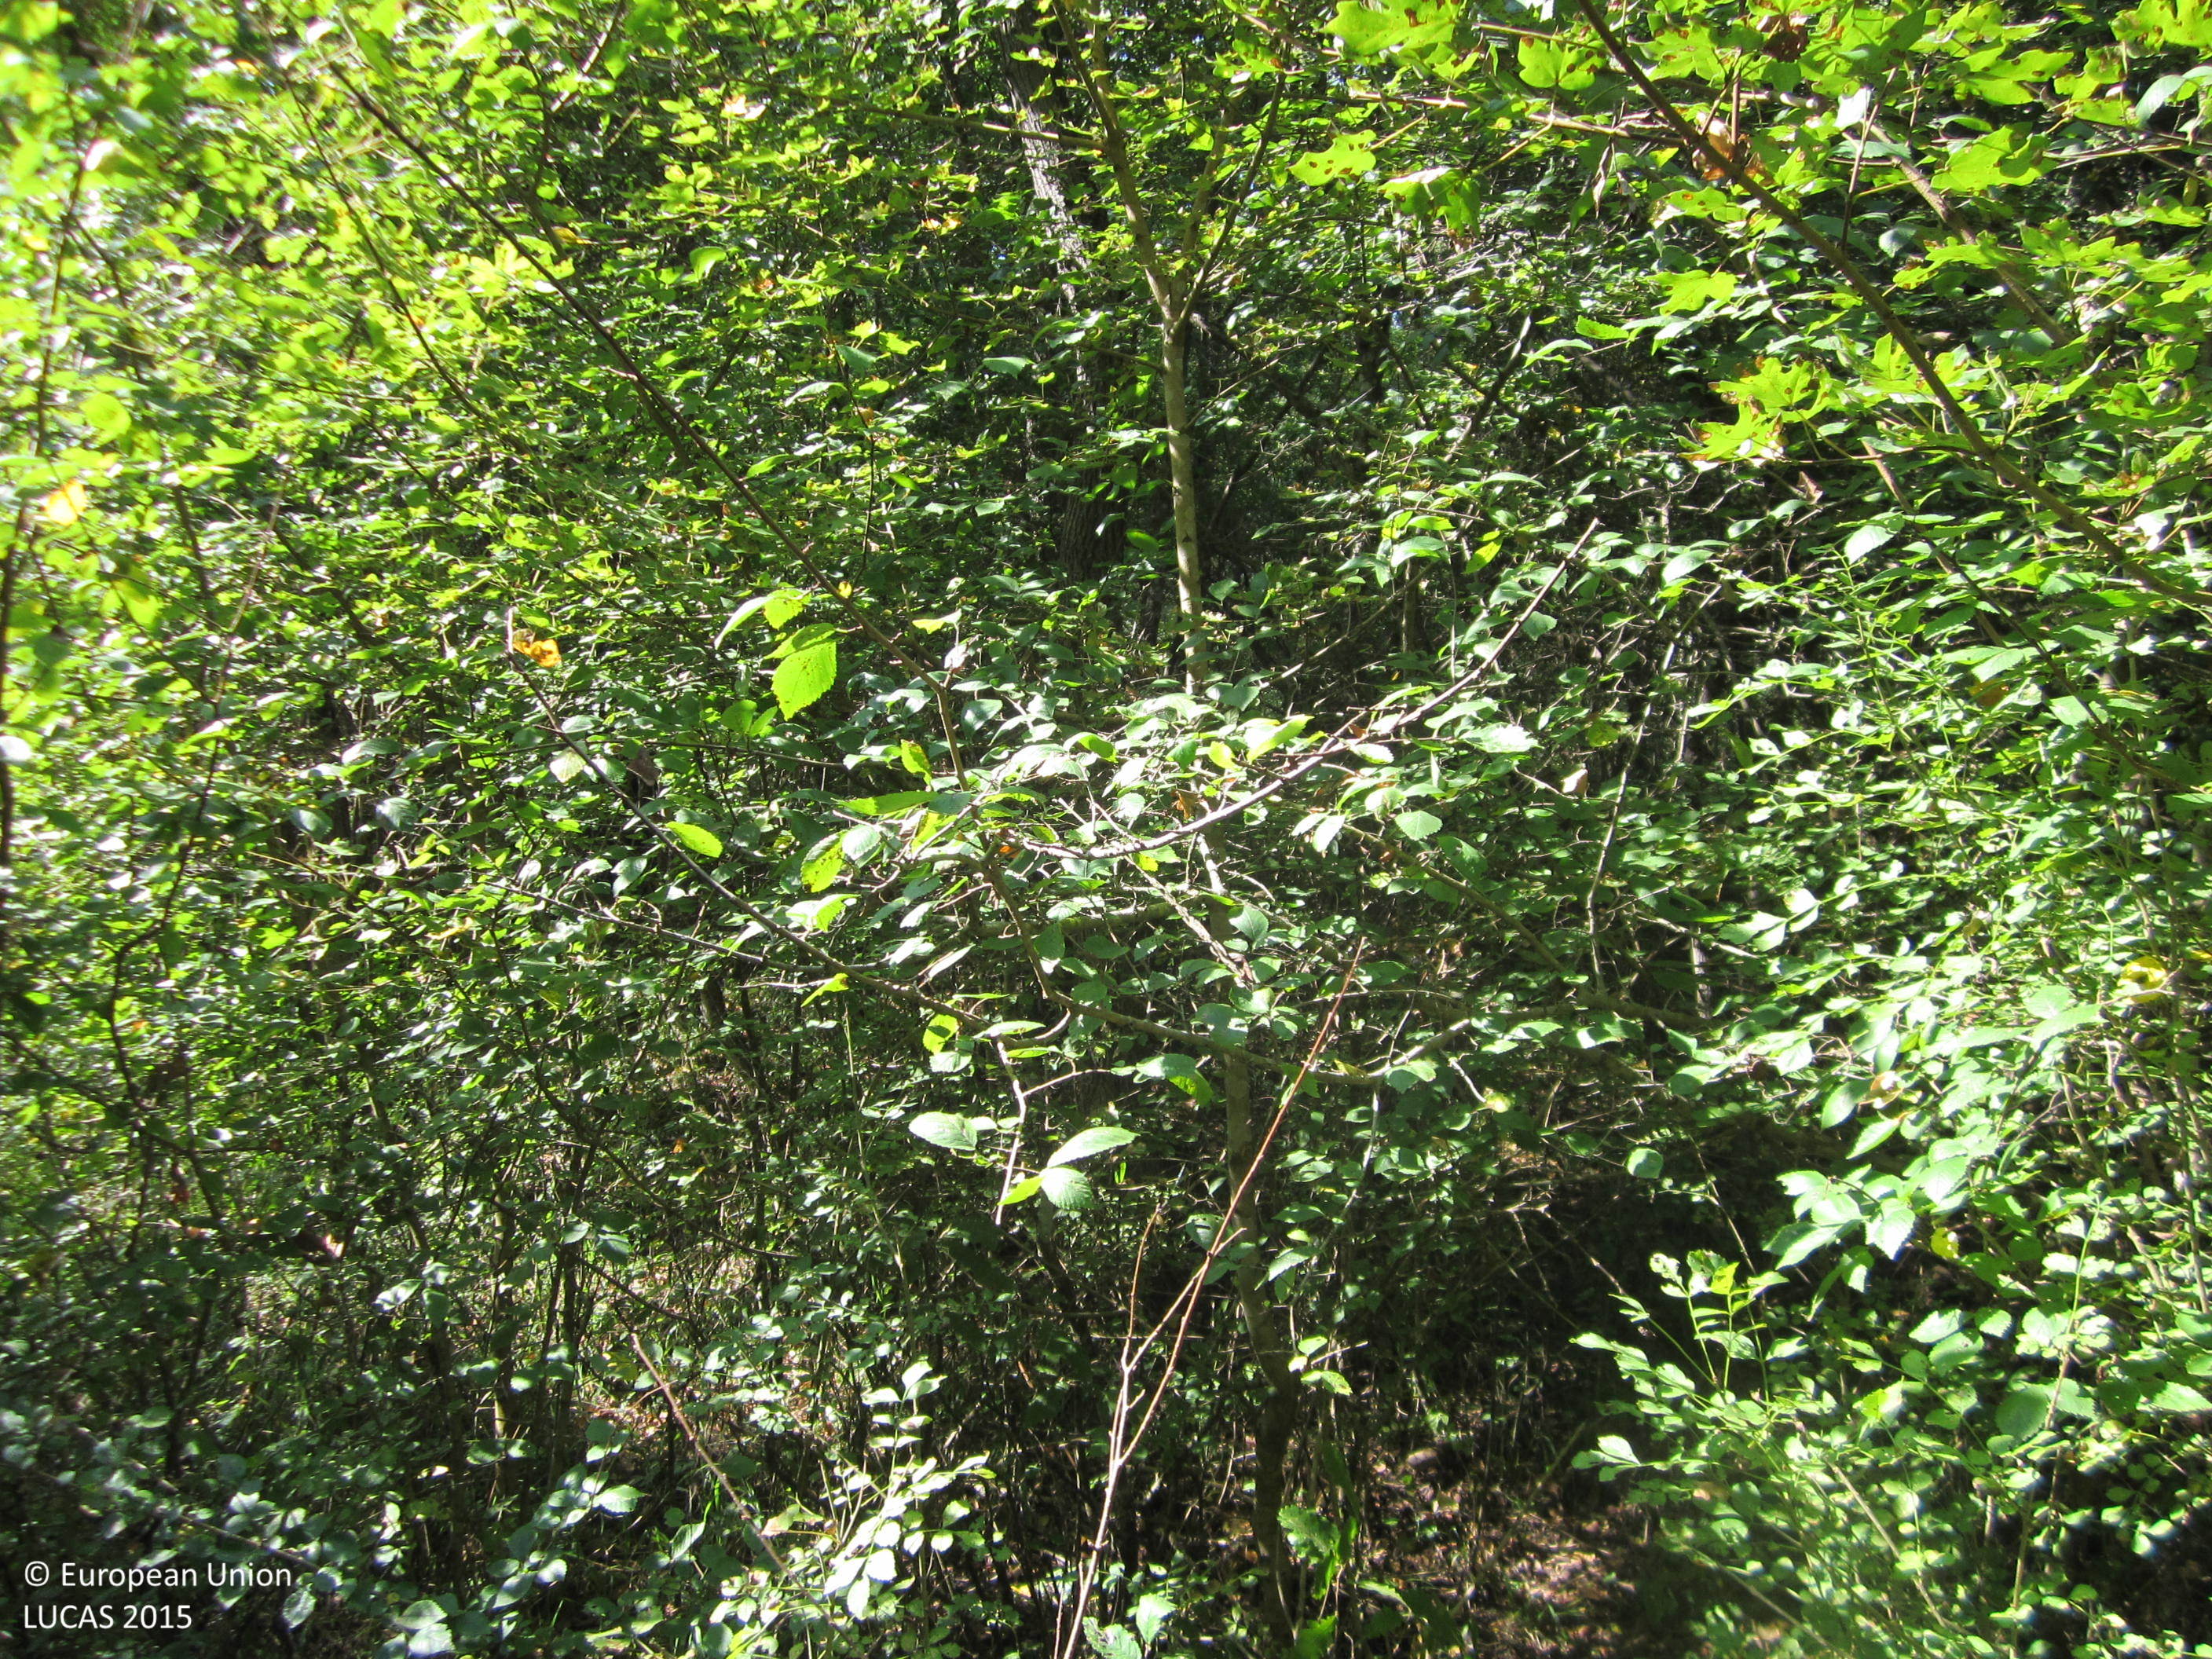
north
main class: Woodland
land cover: Broadleaved woodland
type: mesophytic deciduous forest
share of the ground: > 75 %
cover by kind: broadleaved forest trees 85 %, shrubs 15 %
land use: Forestry
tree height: < 5 m
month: September
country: BG
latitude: 42.2115
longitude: 27.7698
